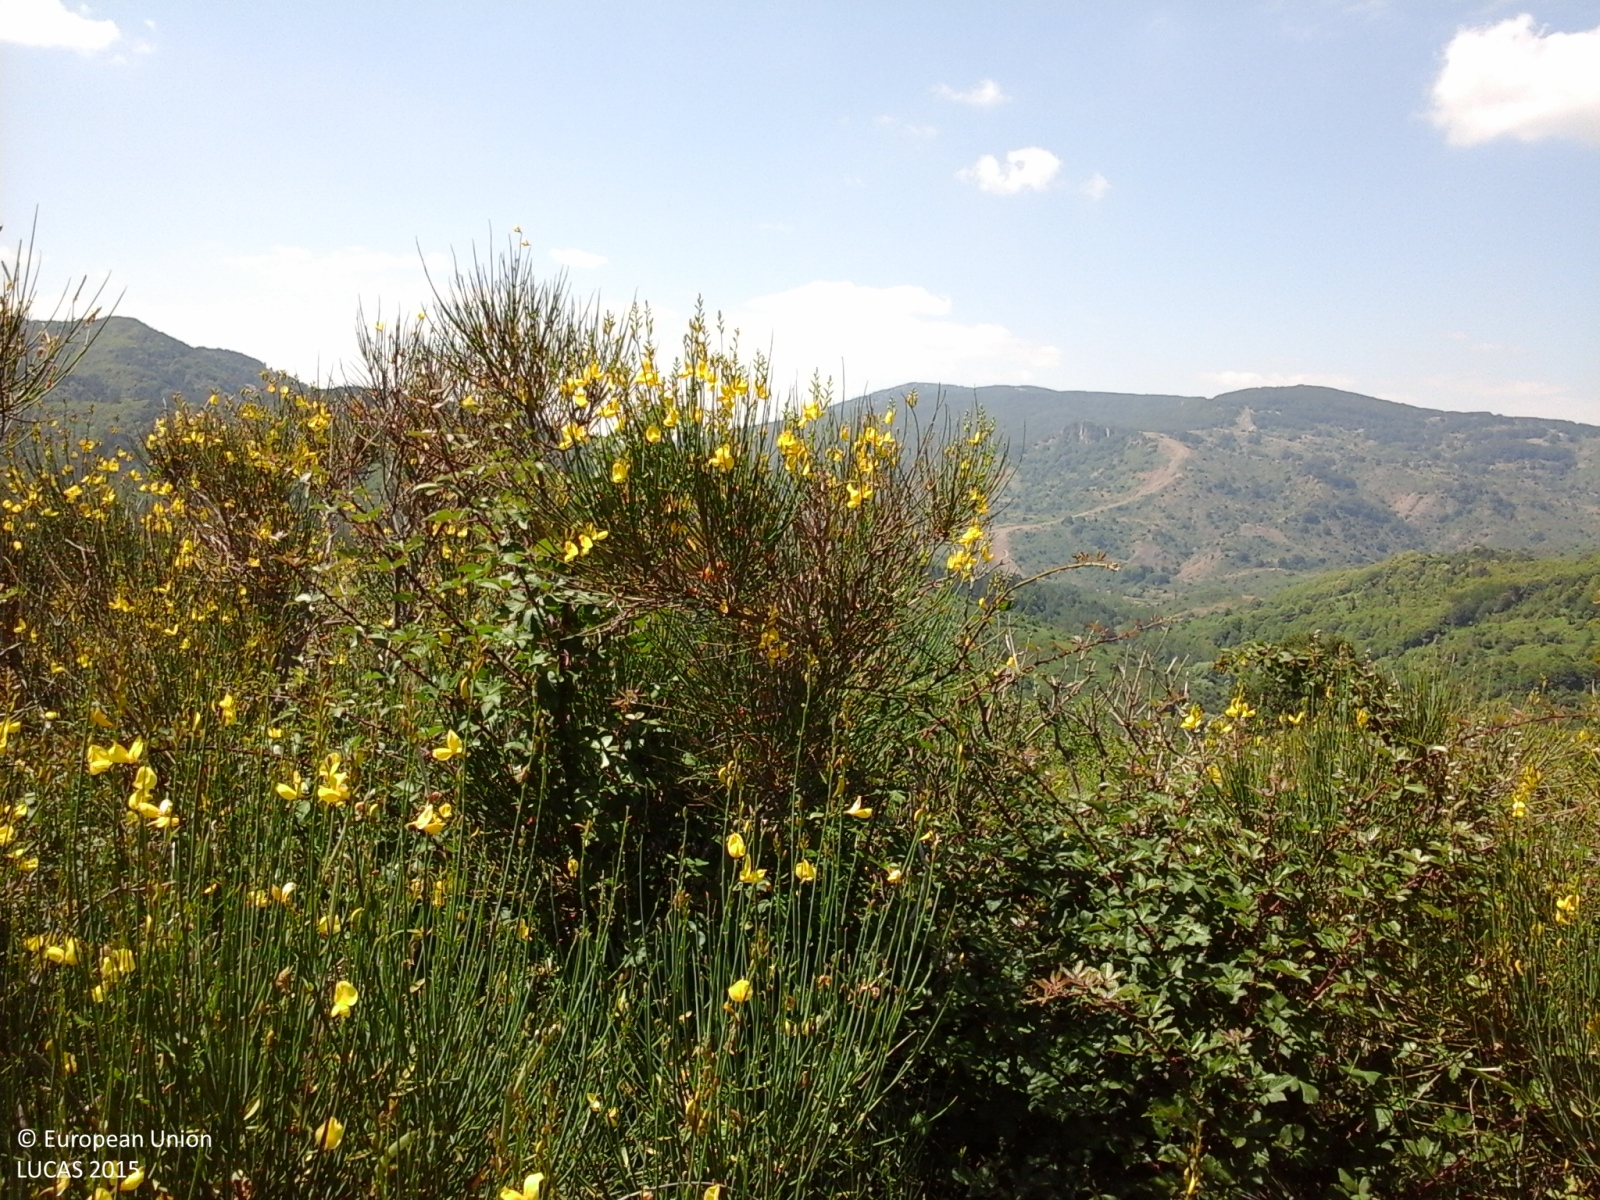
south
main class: Shrubland
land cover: Shrubland with sparse tree cover
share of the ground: > 75 %
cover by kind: shrubs 95 %, broadleaved forest trees 5 %
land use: Agriculture (excluding fallow land and kitchen gardens)
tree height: < 5 m
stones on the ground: 25 - 50 %
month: July
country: IT
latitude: 37.9837
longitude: 14.9197
